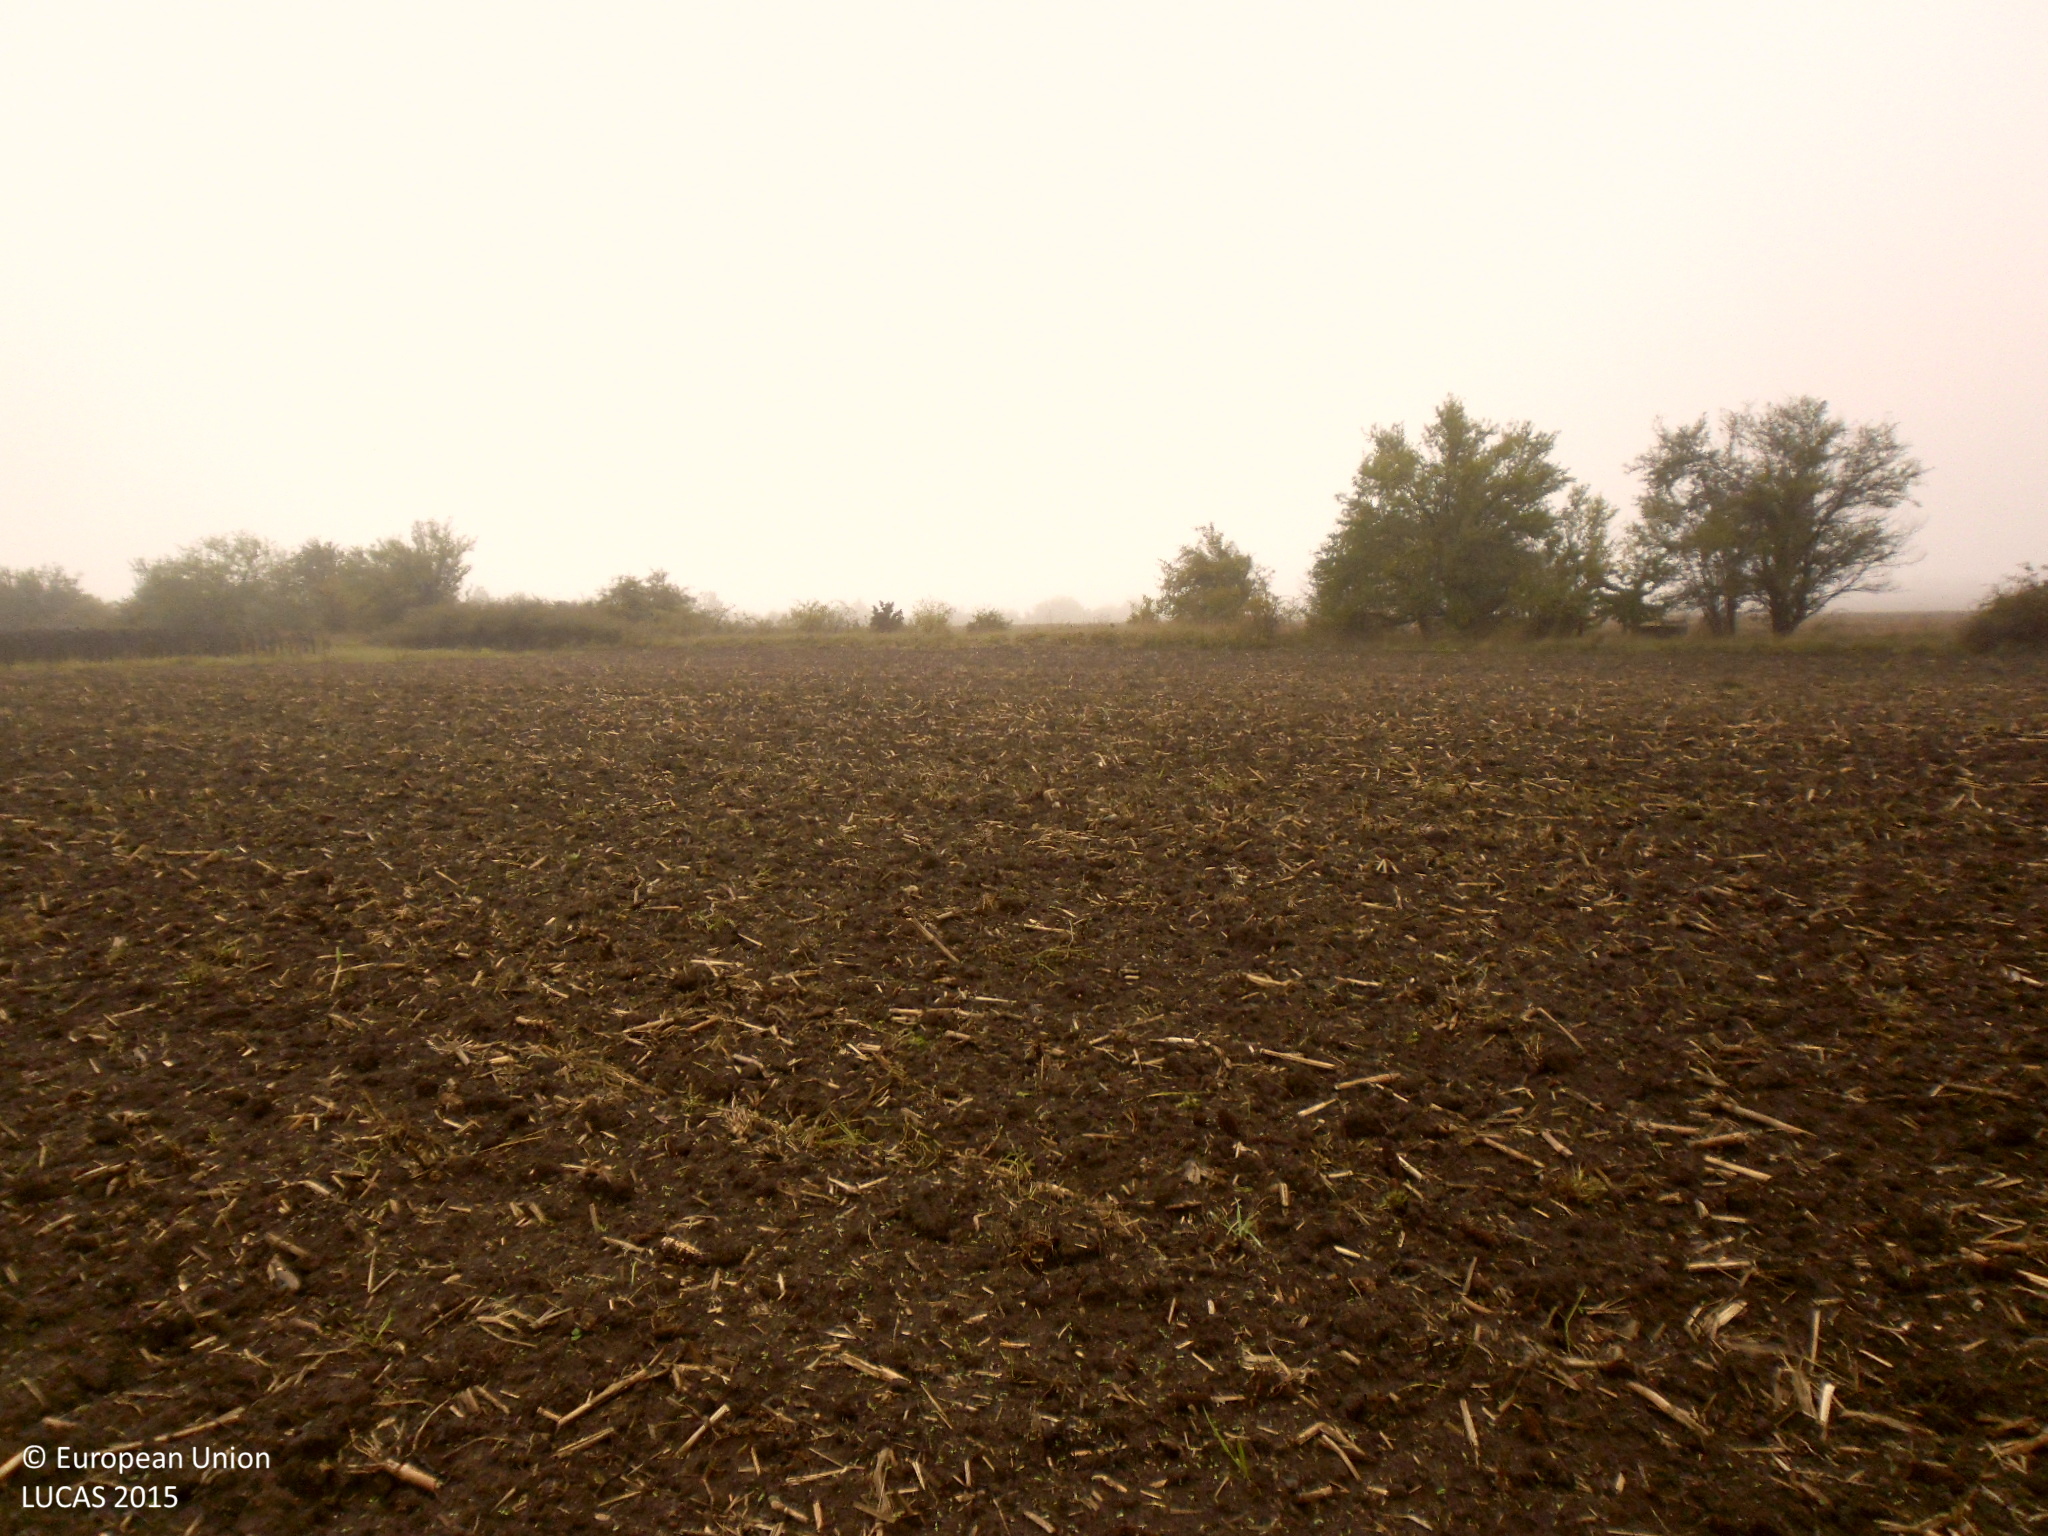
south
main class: Cropland
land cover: Maize
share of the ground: < 10 %
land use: Agriculture (excluding fallow land and kitchen gardens)
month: October
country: BG
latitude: 43.9284
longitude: 22.5780
